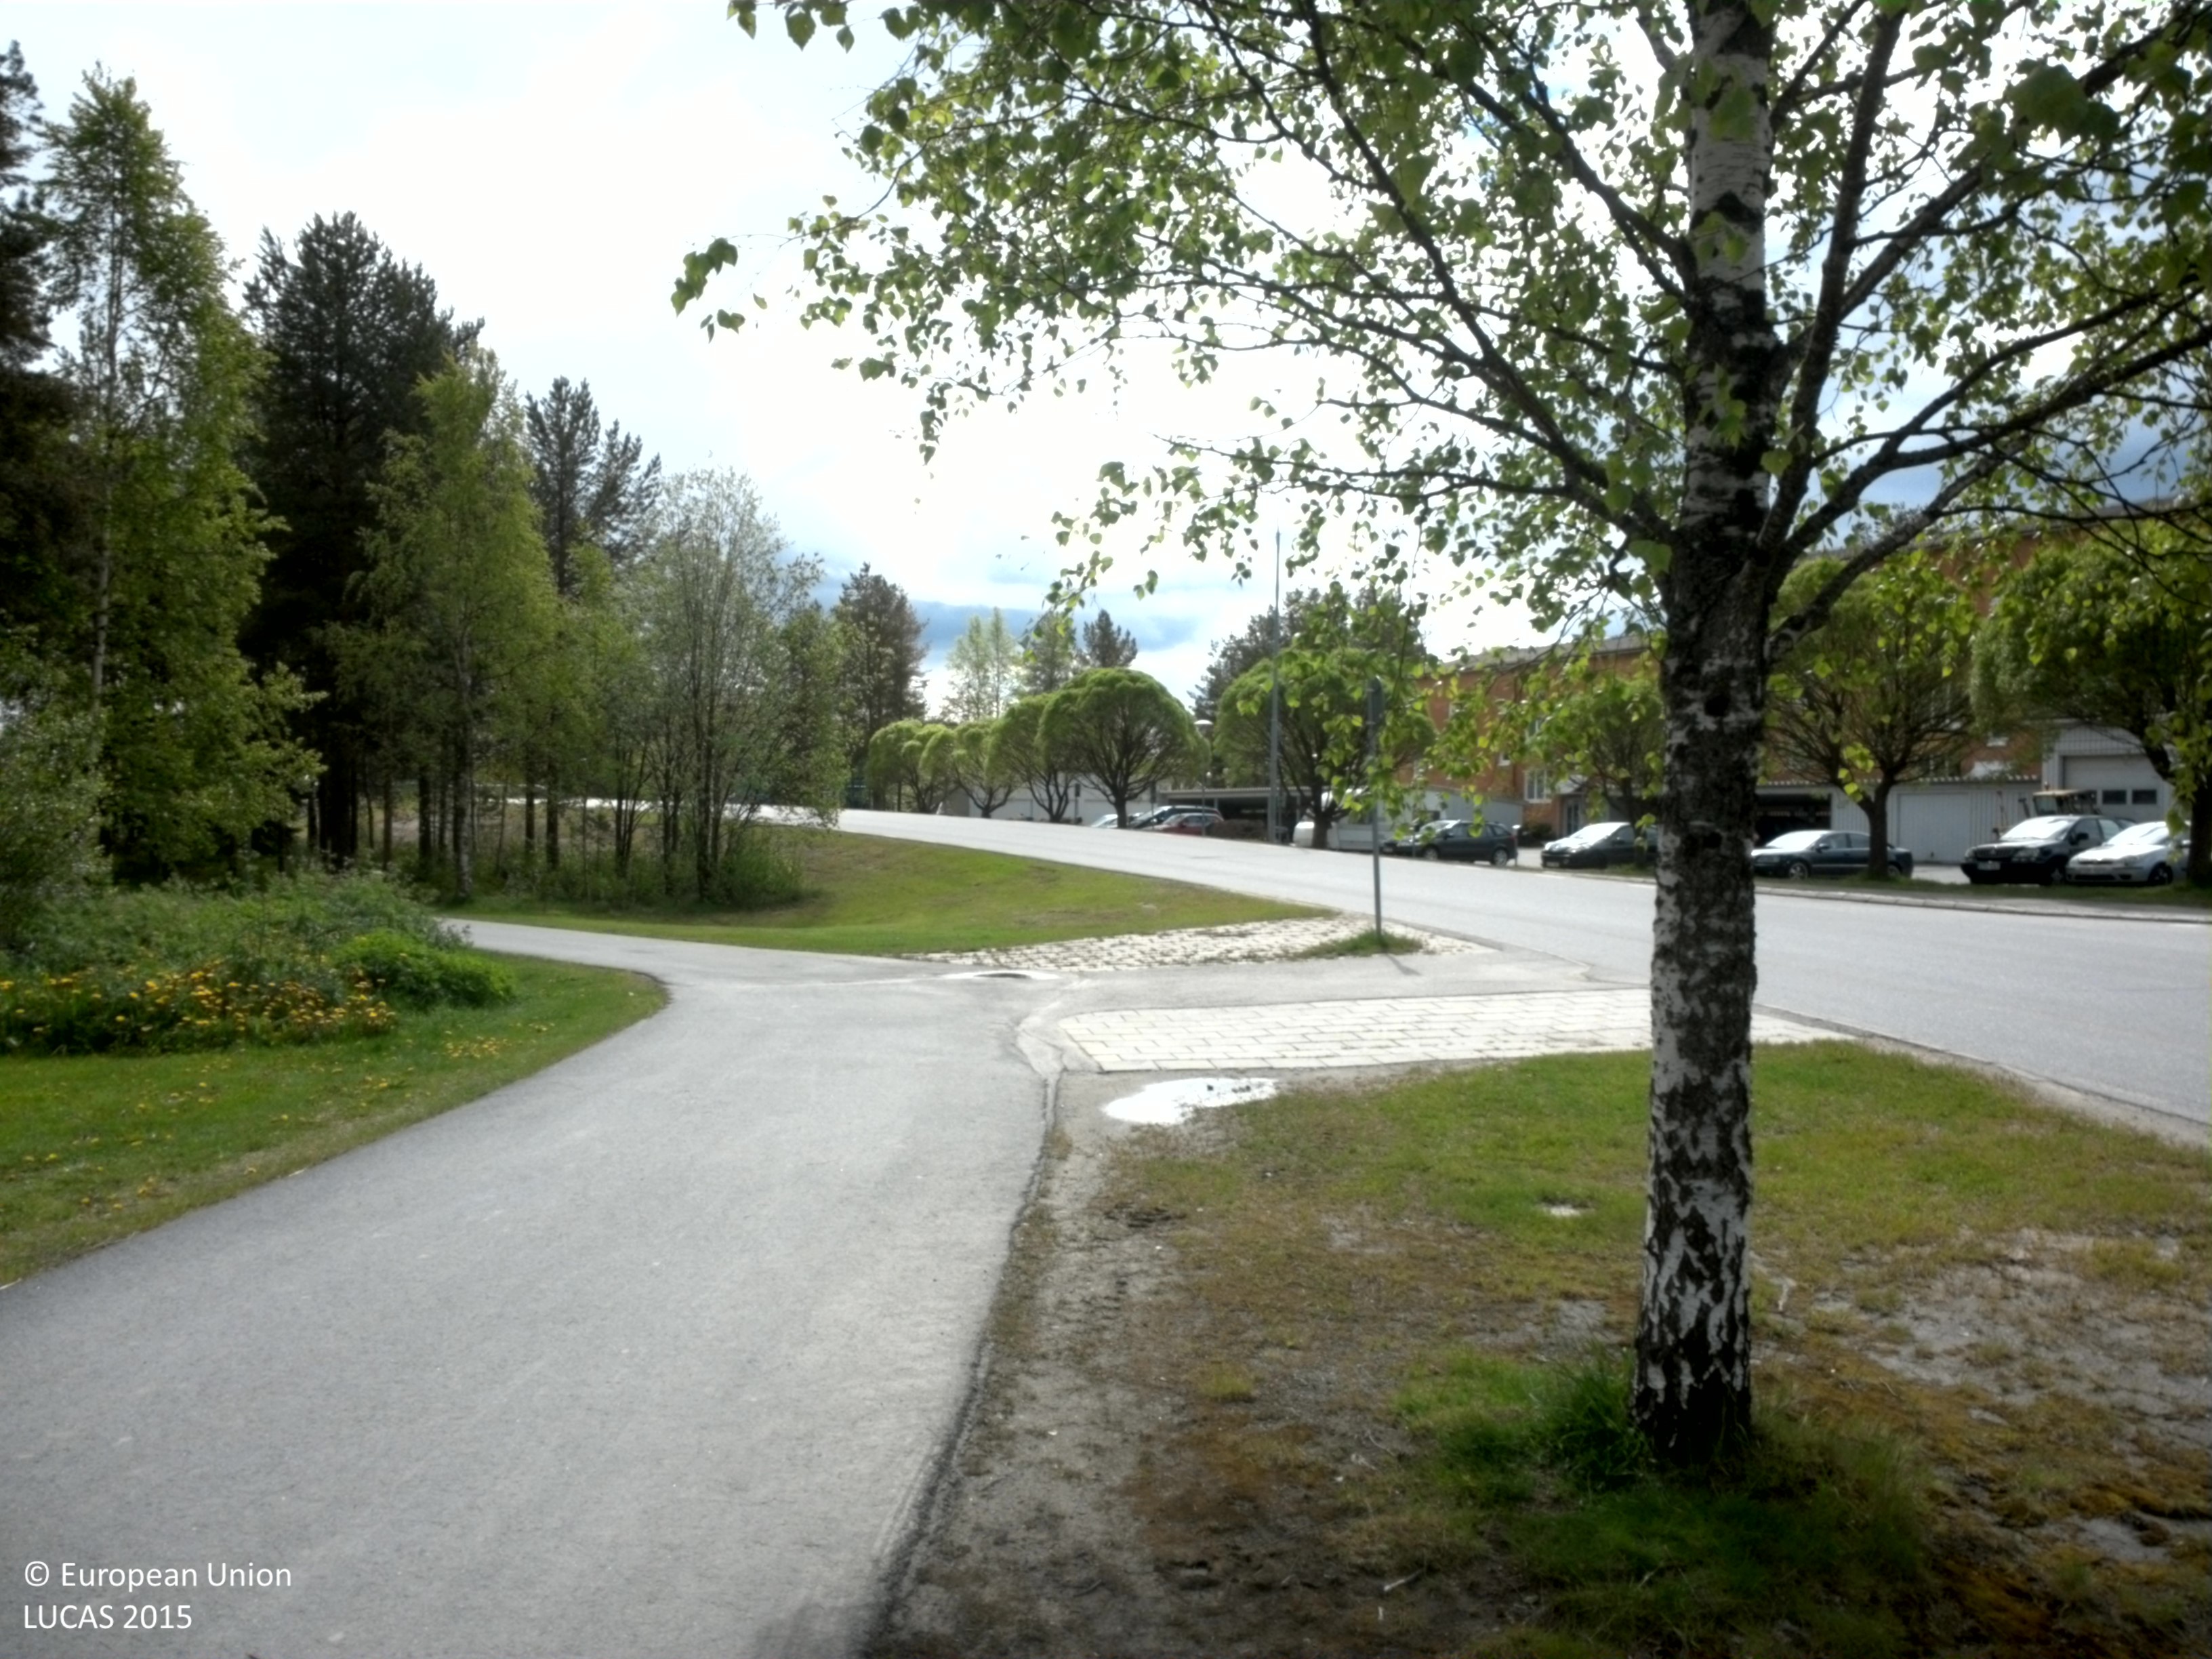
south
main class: Woodland
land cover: Broadleaved woodland
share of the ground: > 75 %
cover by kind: herbaceous plants 70 %, broadleaved forest trees 30 %
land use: Amenities, museums, leisure
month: June
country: SE
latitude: 63.8594
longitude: 20.3370
